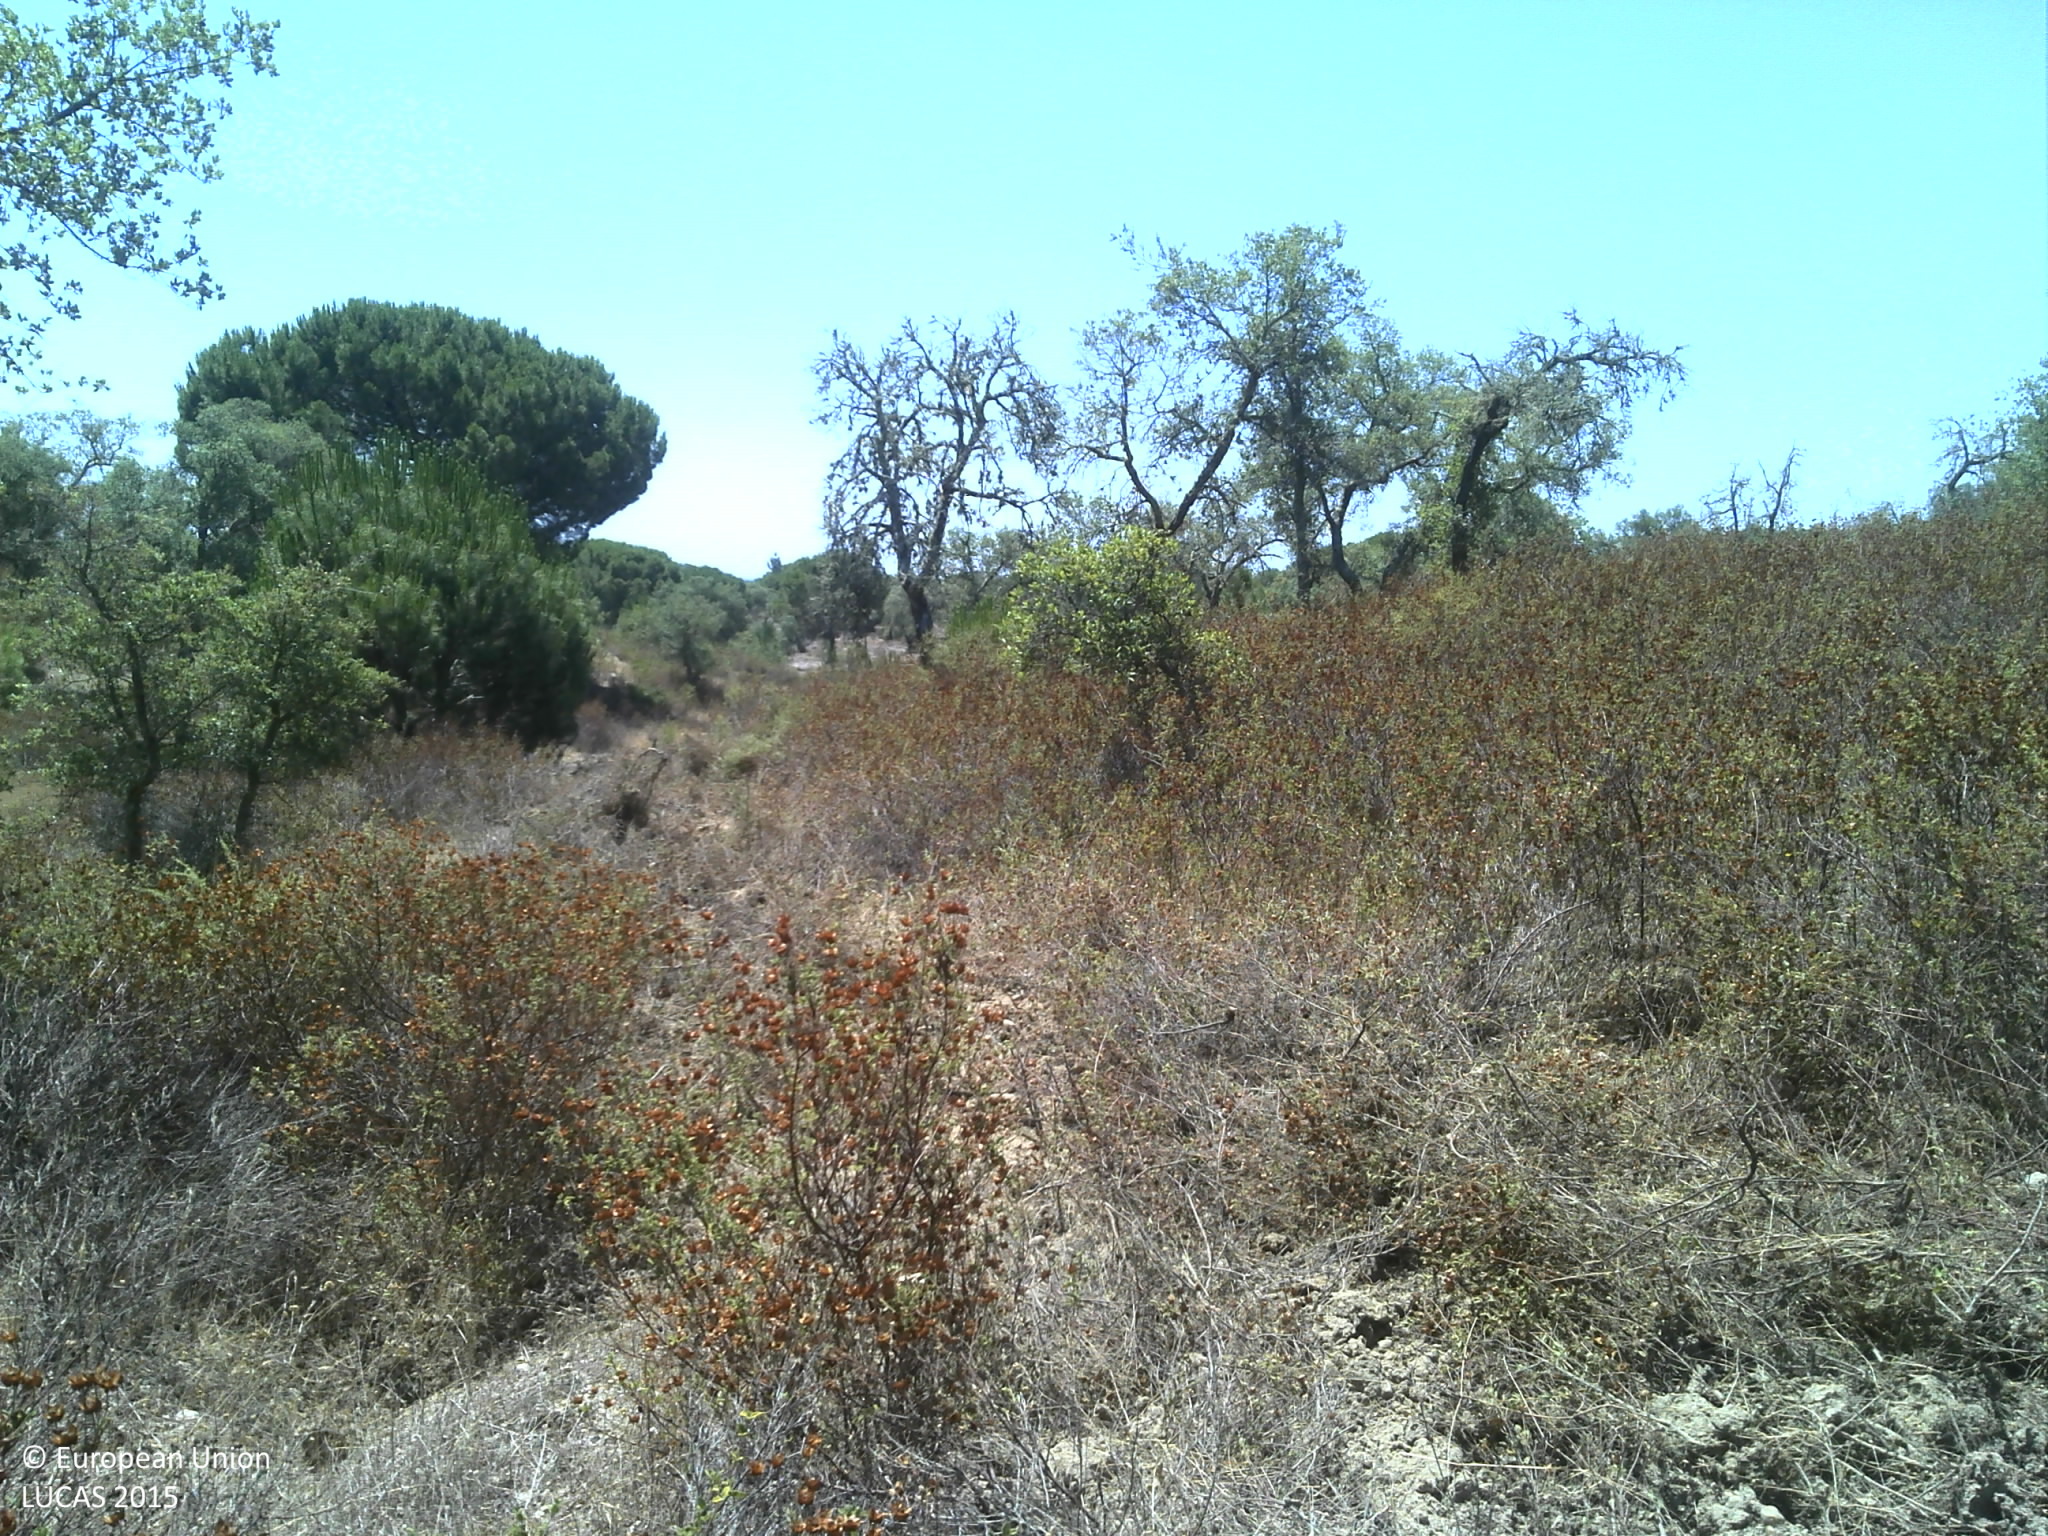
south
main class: Woodland
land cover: Broadleaved woodland
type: broadleaved evergreen forest
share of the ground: 25 - 50 %
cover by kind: unconsolidated bare surface 40 %, broadleaved forest trees 35 %, shrubs 15 %, herbaceous plants 10 %
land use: Forestry
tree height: > 5 m
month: July
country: PT
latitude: 39.0293
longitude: -8.2979
